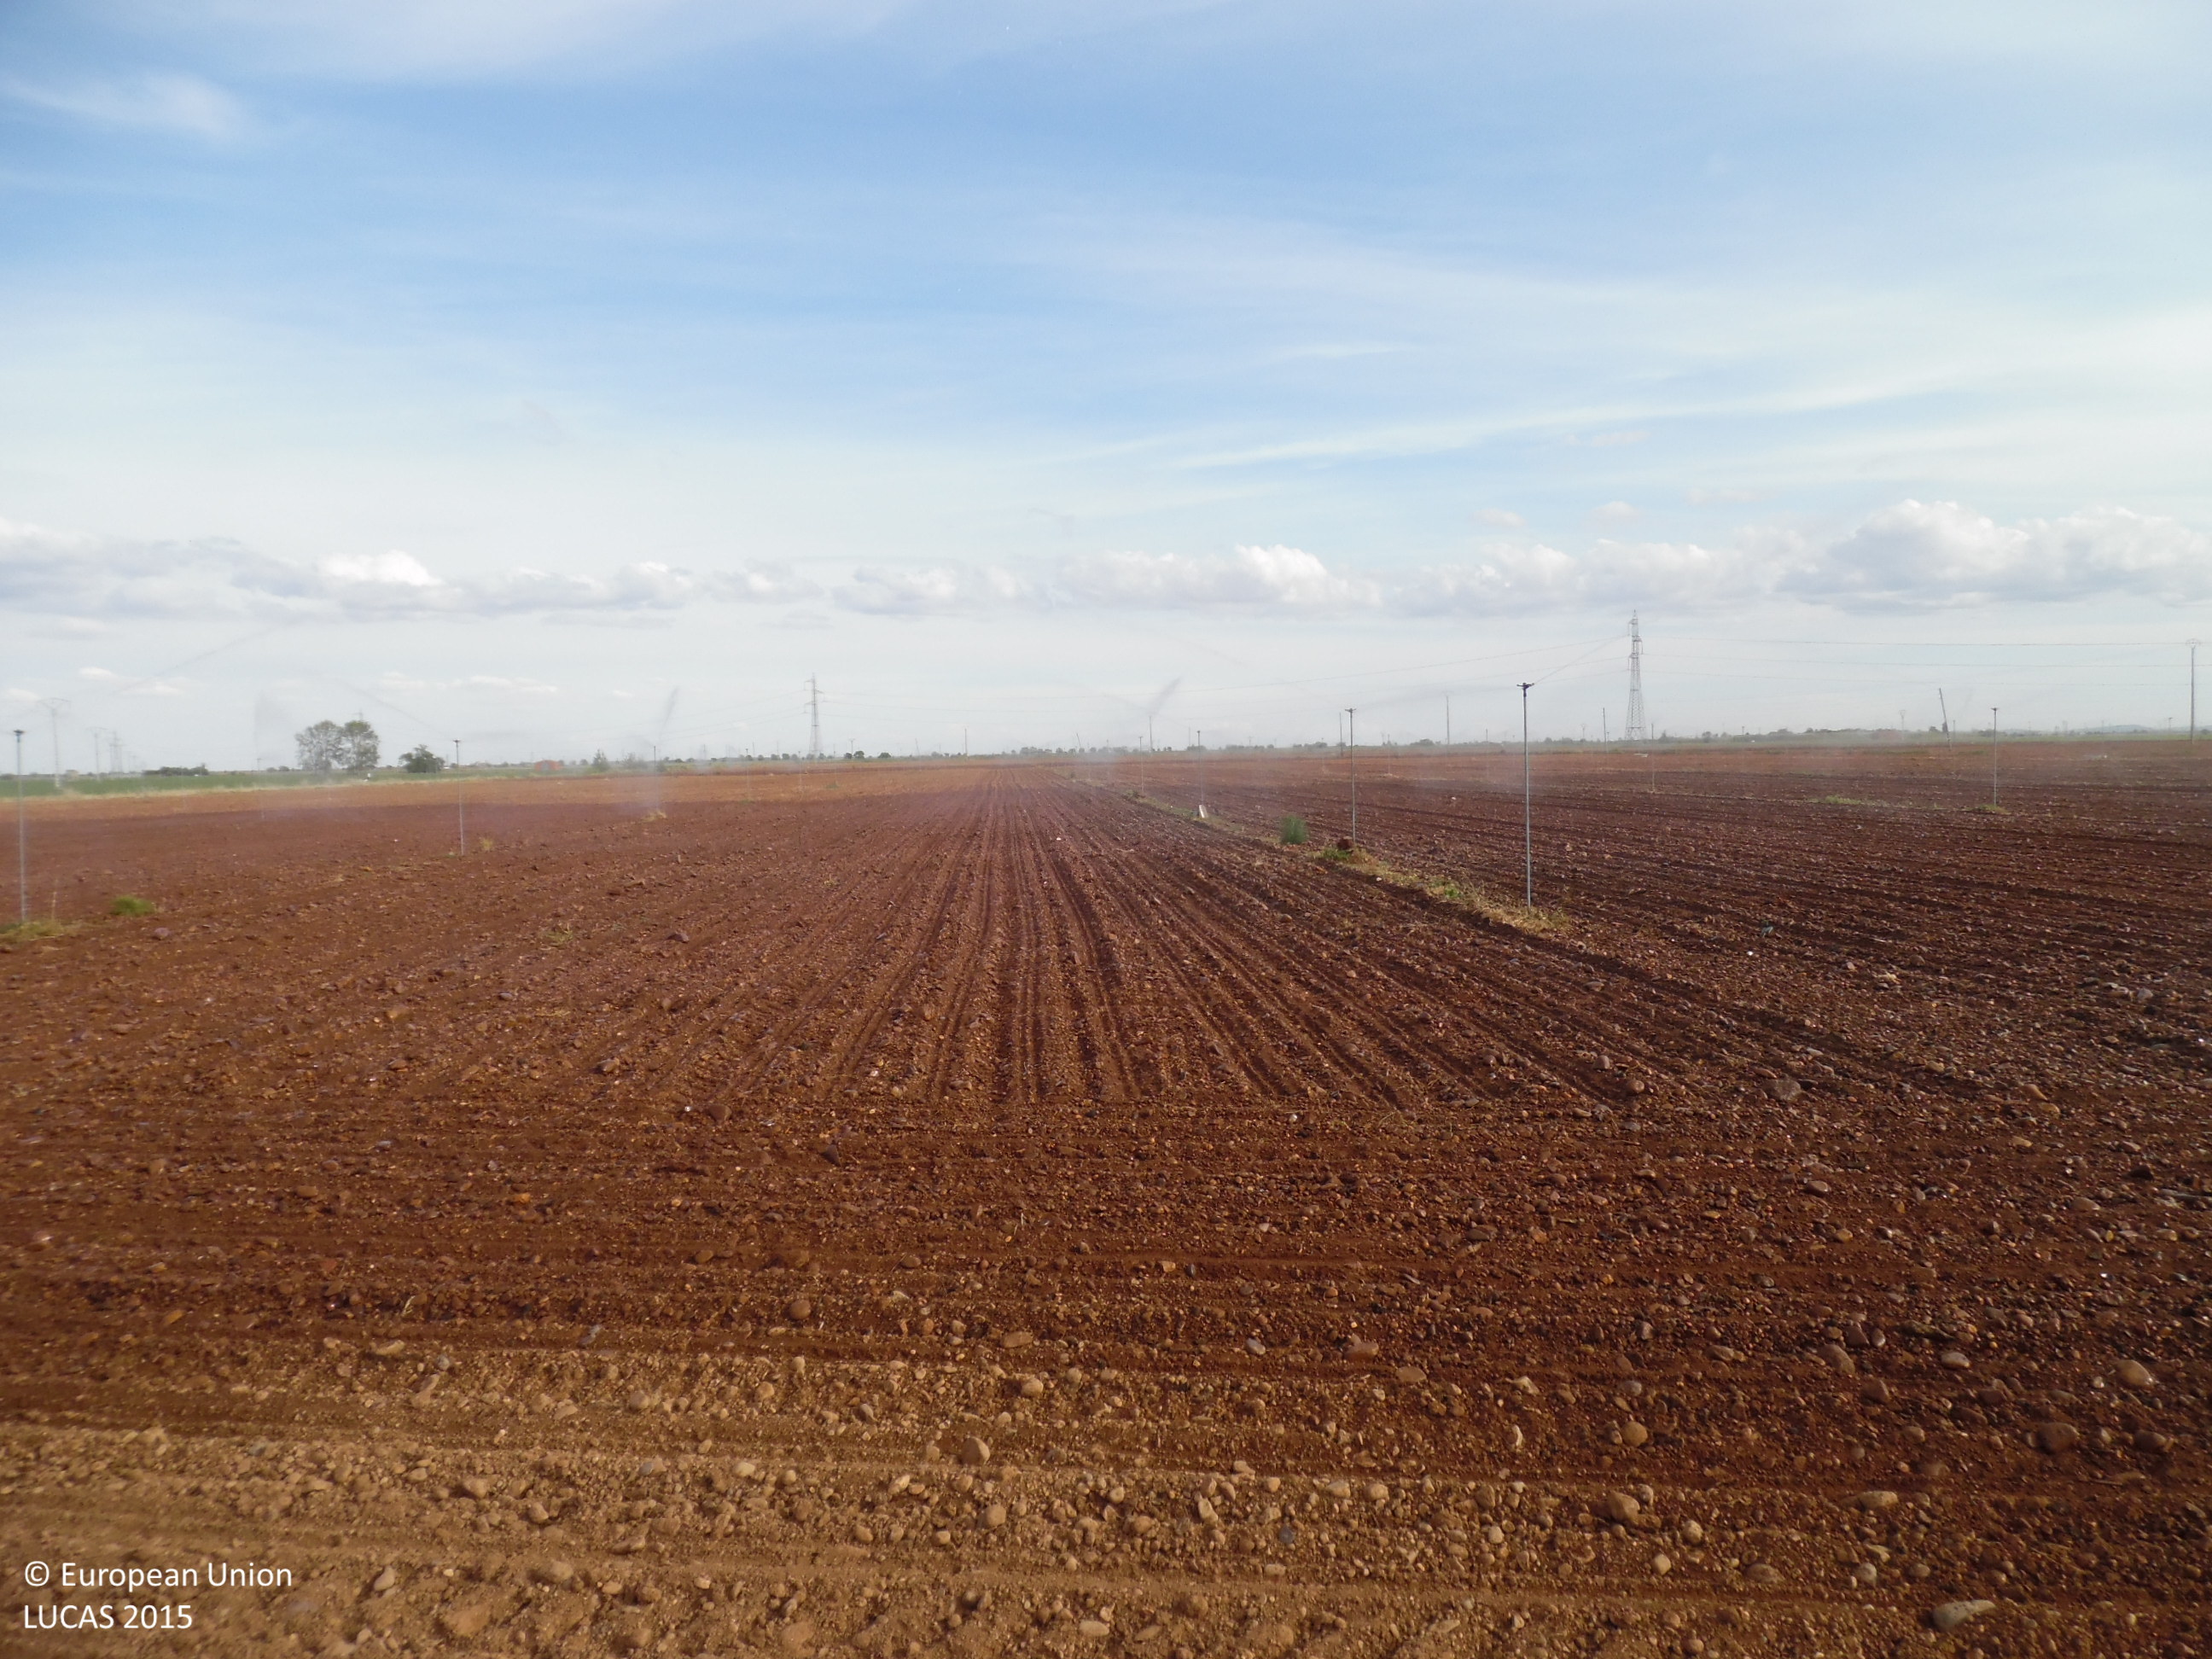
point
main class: Cropland
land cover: Maize
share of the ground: < 10 %
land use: Agriculture (excluding fallow land and kitchen gardens)
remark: Temporary flooded
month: June
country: ES
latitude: 42.3362
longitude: -5.7171
